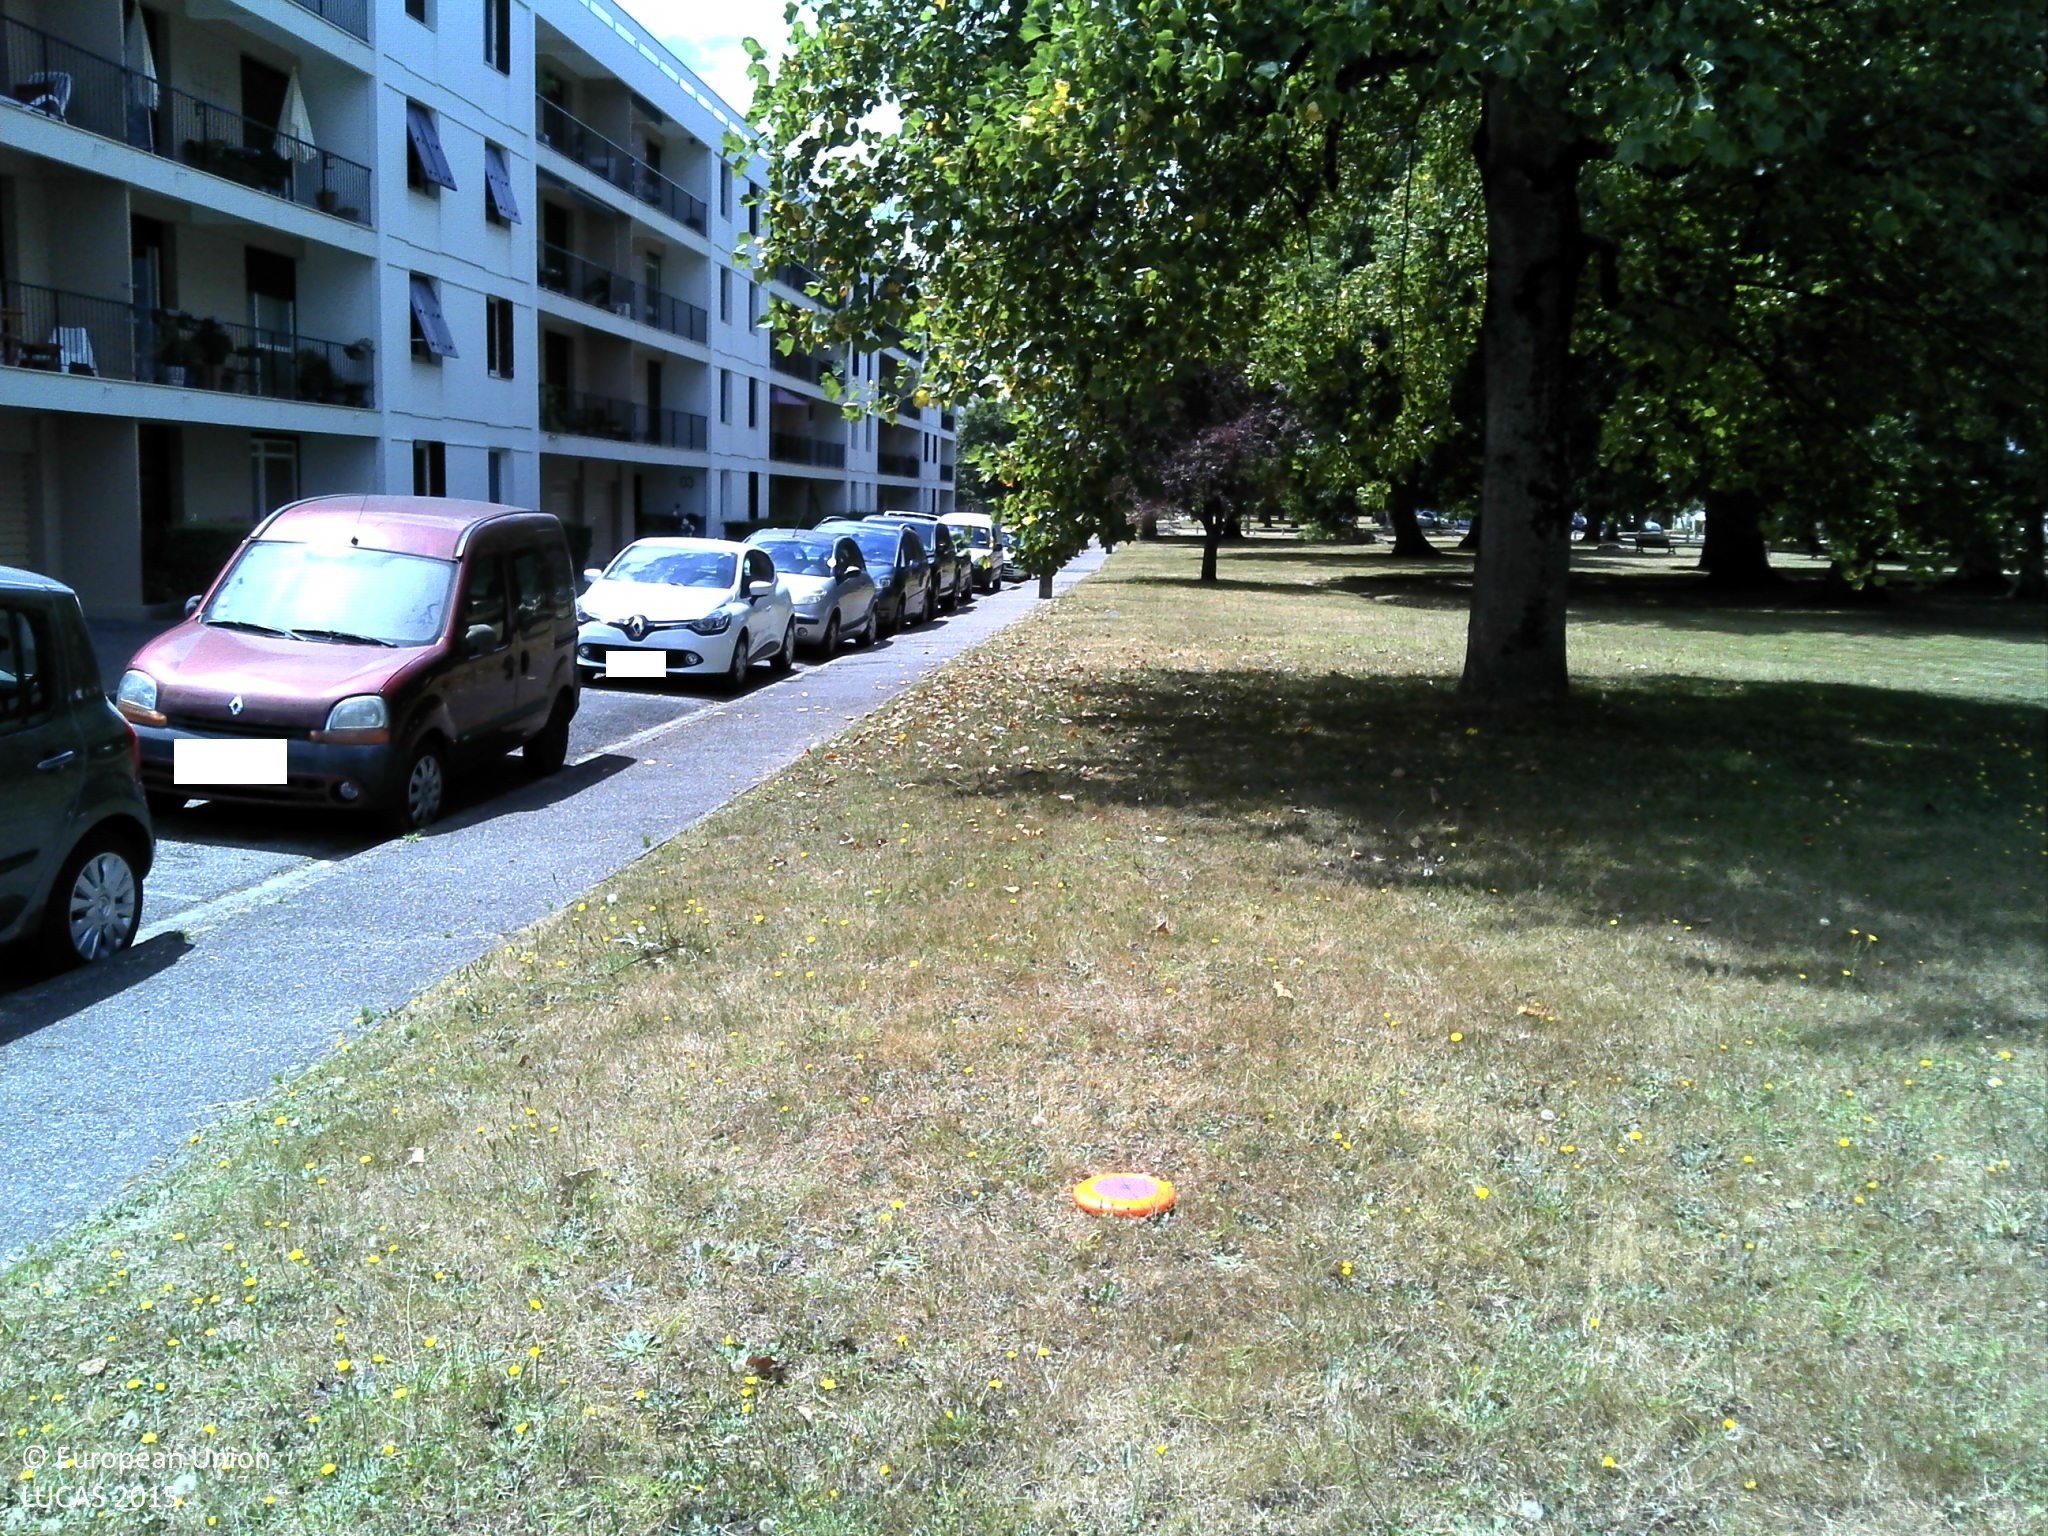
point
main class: Grassland
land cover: Grassland with sparse tree/shrub cover
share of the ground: > 75 %
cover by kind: herbaceous plants 95 %, broadleaved forest trees 5 %
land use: Amenities, museums, leisure
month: July
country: FR
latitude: 44.8565
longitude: -0.6362
